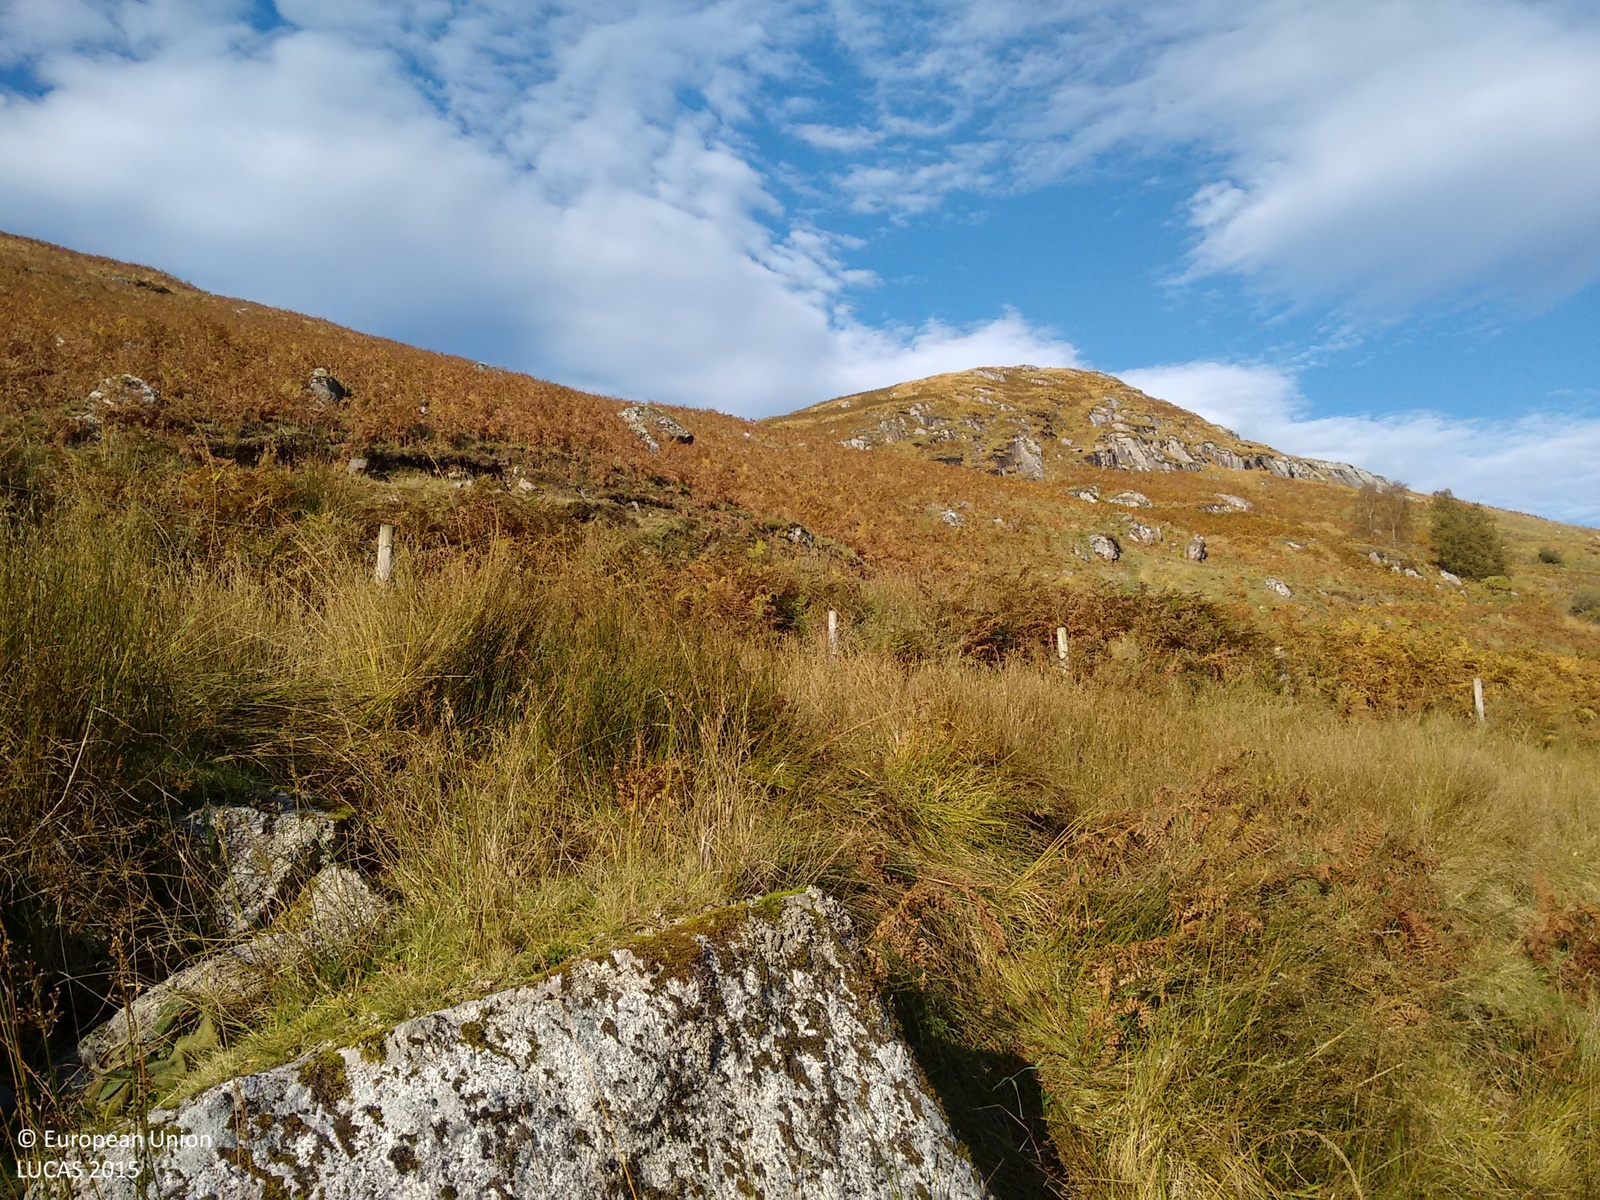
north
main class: Grassland
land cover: Grassland without tree/shrub cover
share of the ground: > 75 %
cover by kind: herbaceous plants 100 %
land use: Agriculture (excluding fallow land and kitchen gardens)
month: October
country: GB
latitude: 56.5925
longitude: -5.6765
